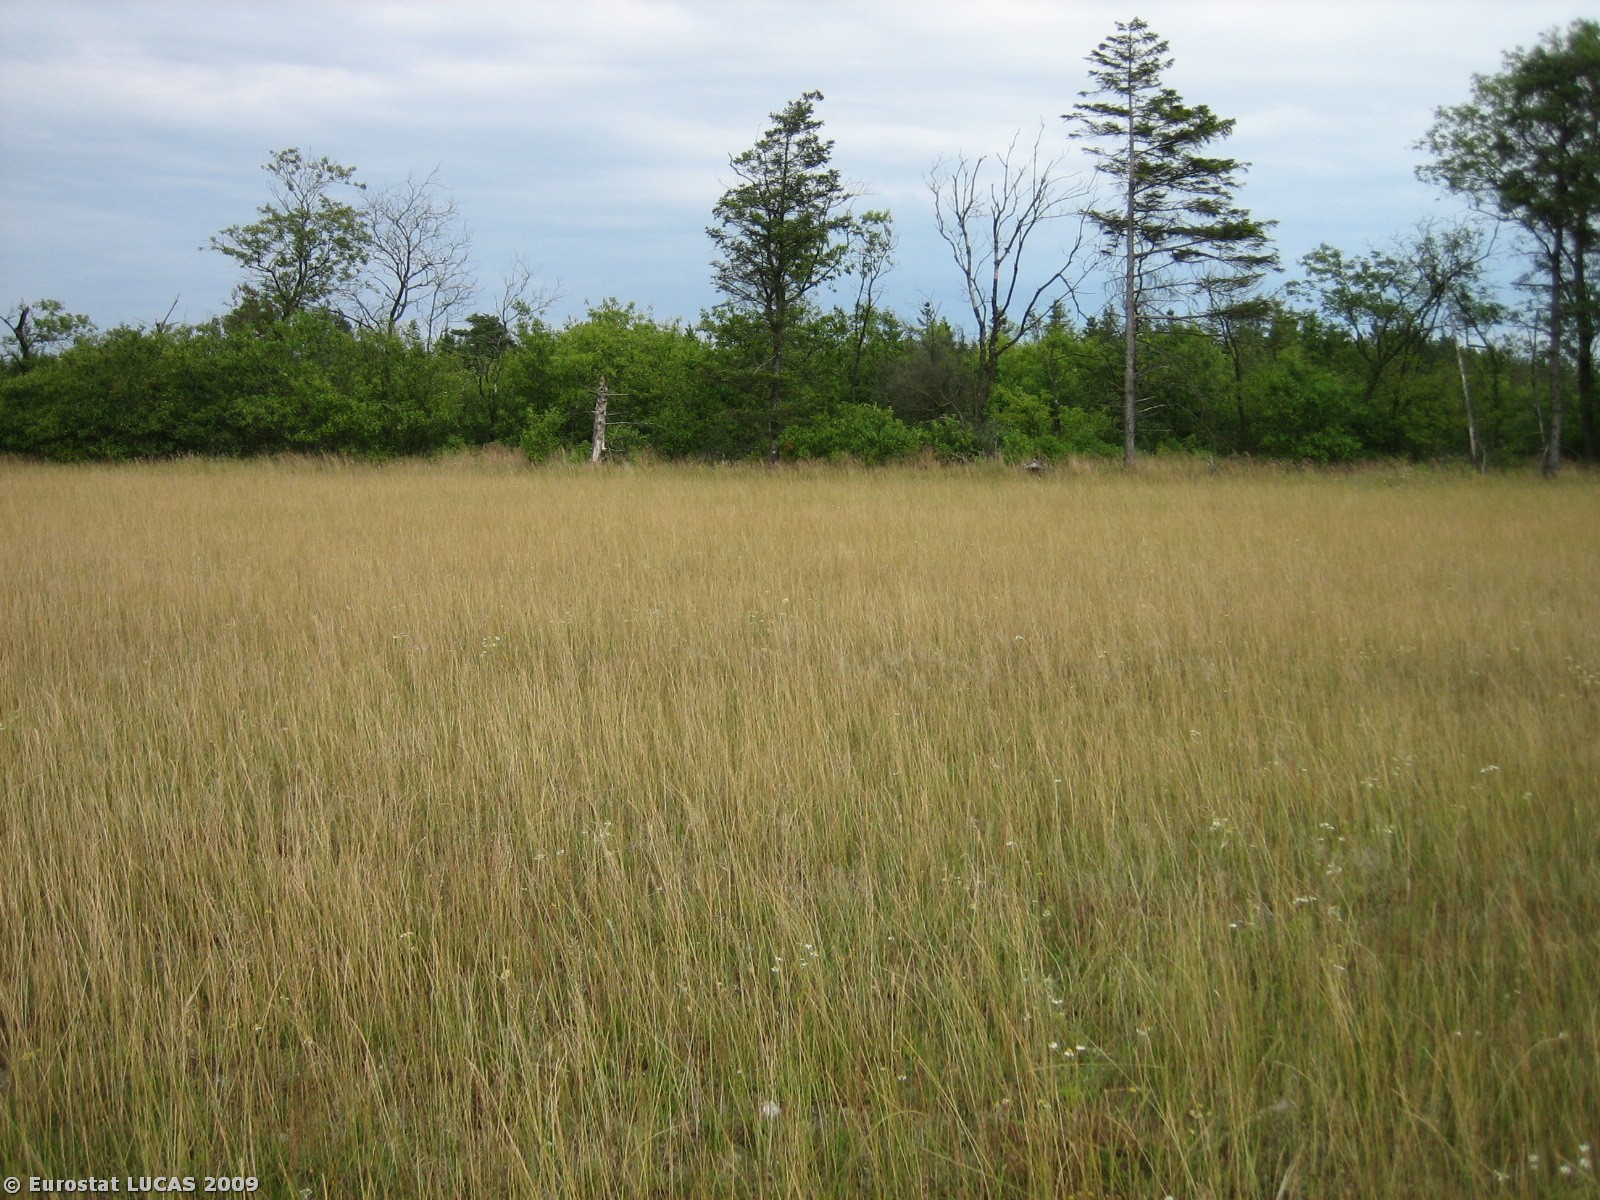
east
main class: Grassland
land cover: Grassland without tree/shrub cover
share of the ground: > 75 %
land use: Fallow land
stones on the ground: 10 - 25 %
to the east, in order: Grassland without tree/shrub cover; Broadleaved woodland; Fences; Broadleaved woodland; Grassland with sparse tree/shrub cover; Fences; Tracks; Grass margins; Coniferous woodland; Spontaneously vegetated surfaces
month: July
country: DK
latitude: 55.8403
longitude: 8.7717
